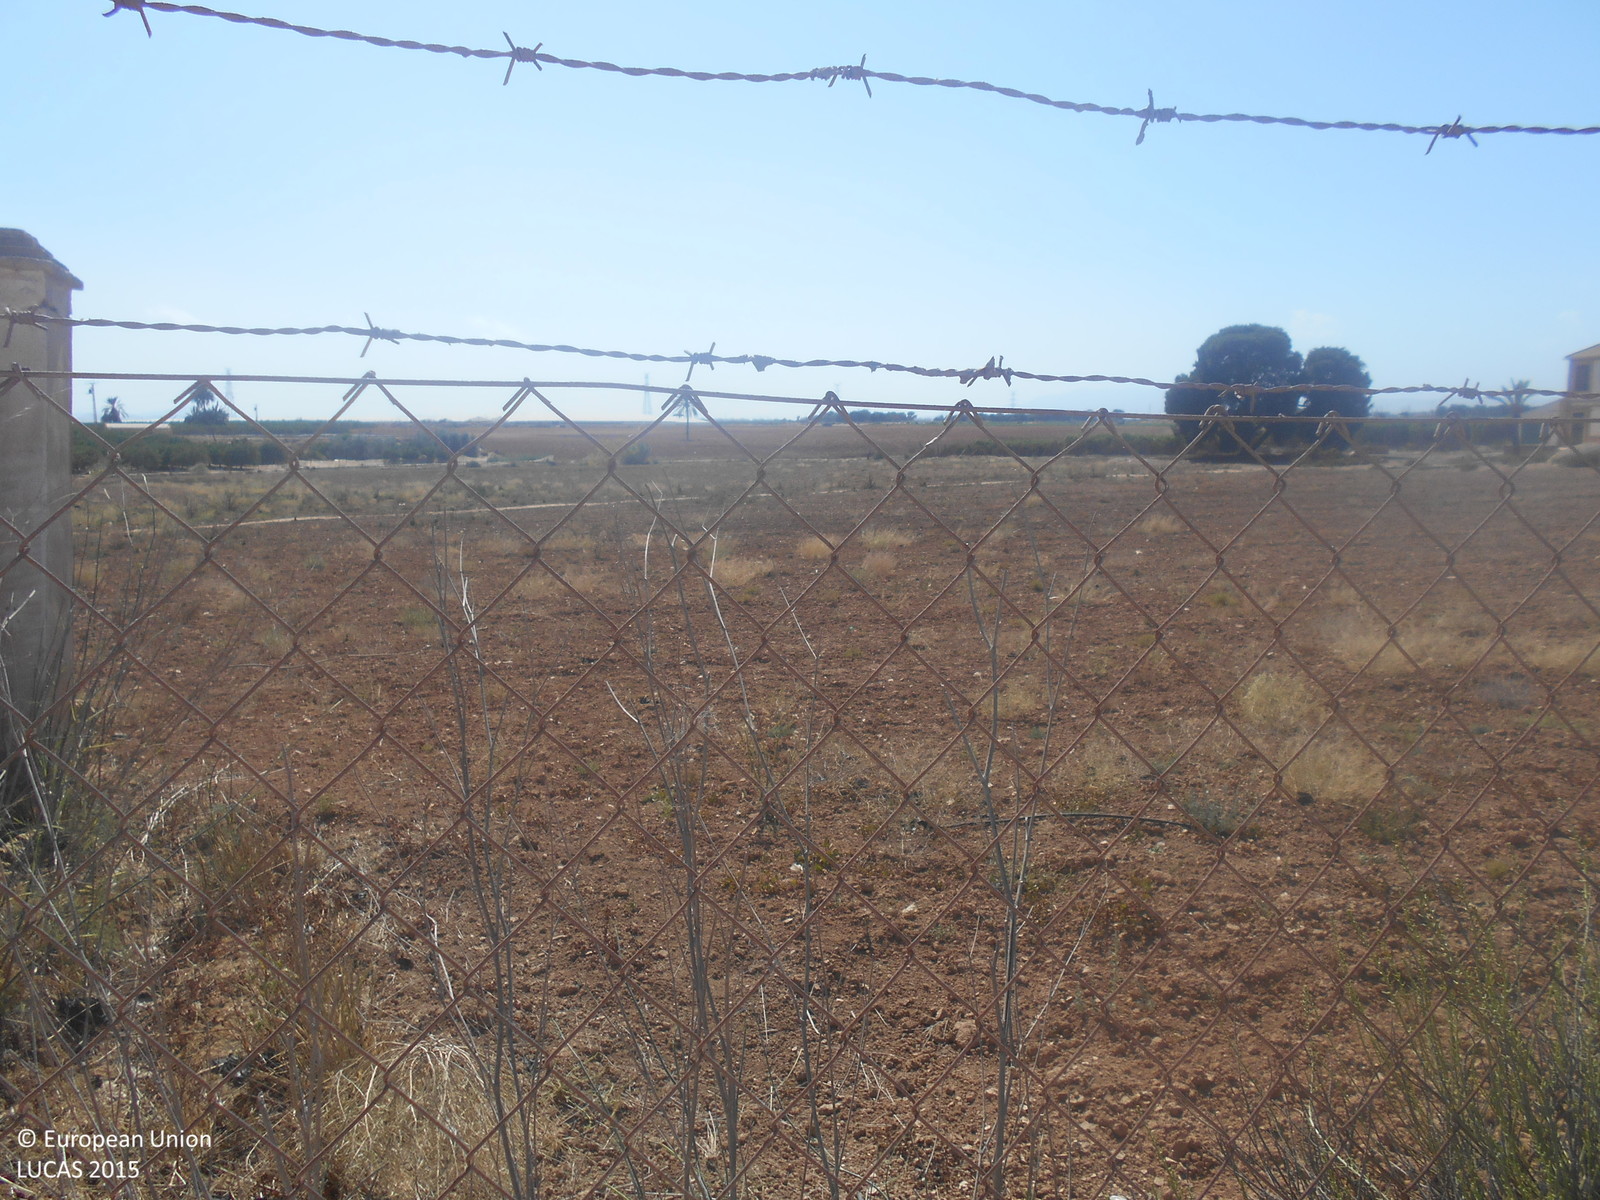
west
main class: Grassland
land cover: Grassland without tree/shrub cover
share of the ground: 10 - 25 %
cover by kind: unconsolidated bare surface 85 %, herbaceous plants 15 %
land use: Agriculture (excluding fallow land and kitchen gardens)
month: May
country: ES
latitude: 37.7910
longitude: -0.9390
